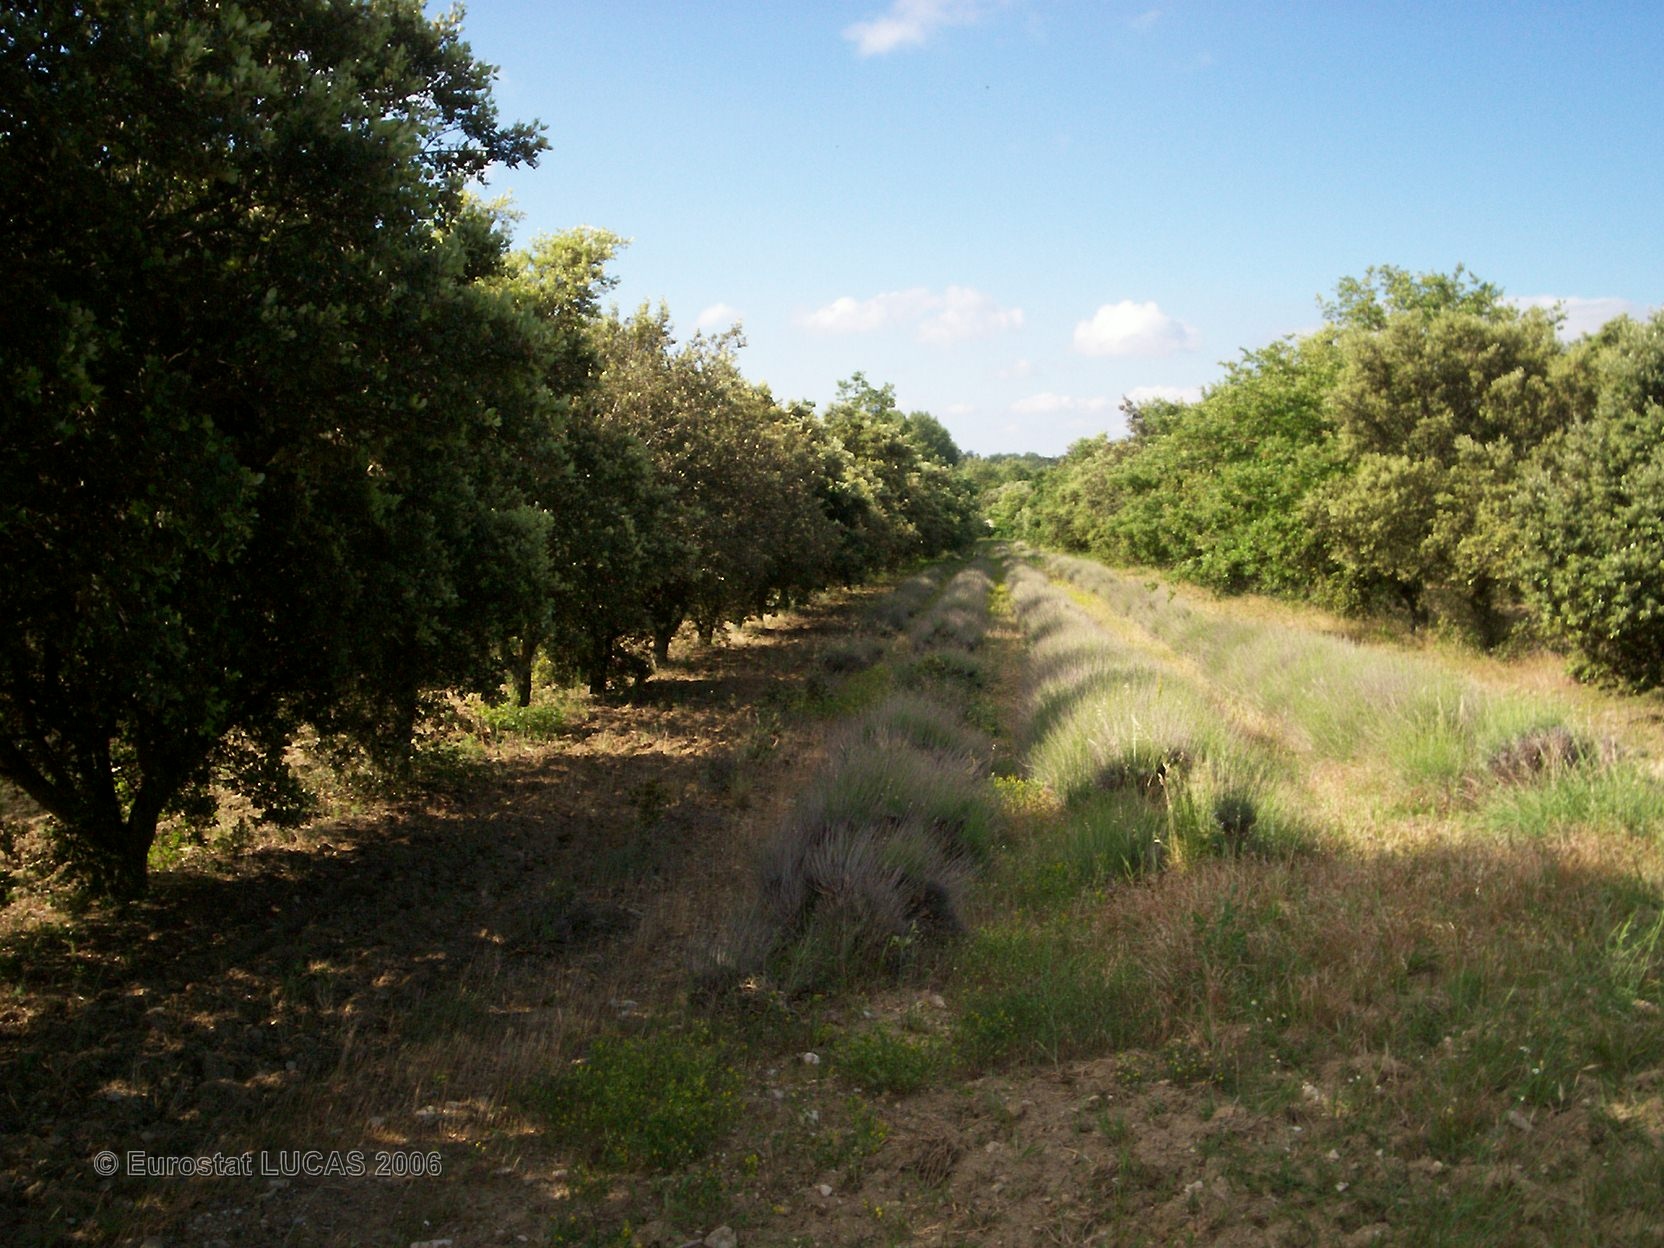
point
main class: Woodland
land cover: Broadleaved forest
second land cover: Permanent industrial crops
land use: Agriculture (excluding fallow land and kitchen gardens)
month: June
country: FR
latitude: 44.4249
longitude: 4.9200
